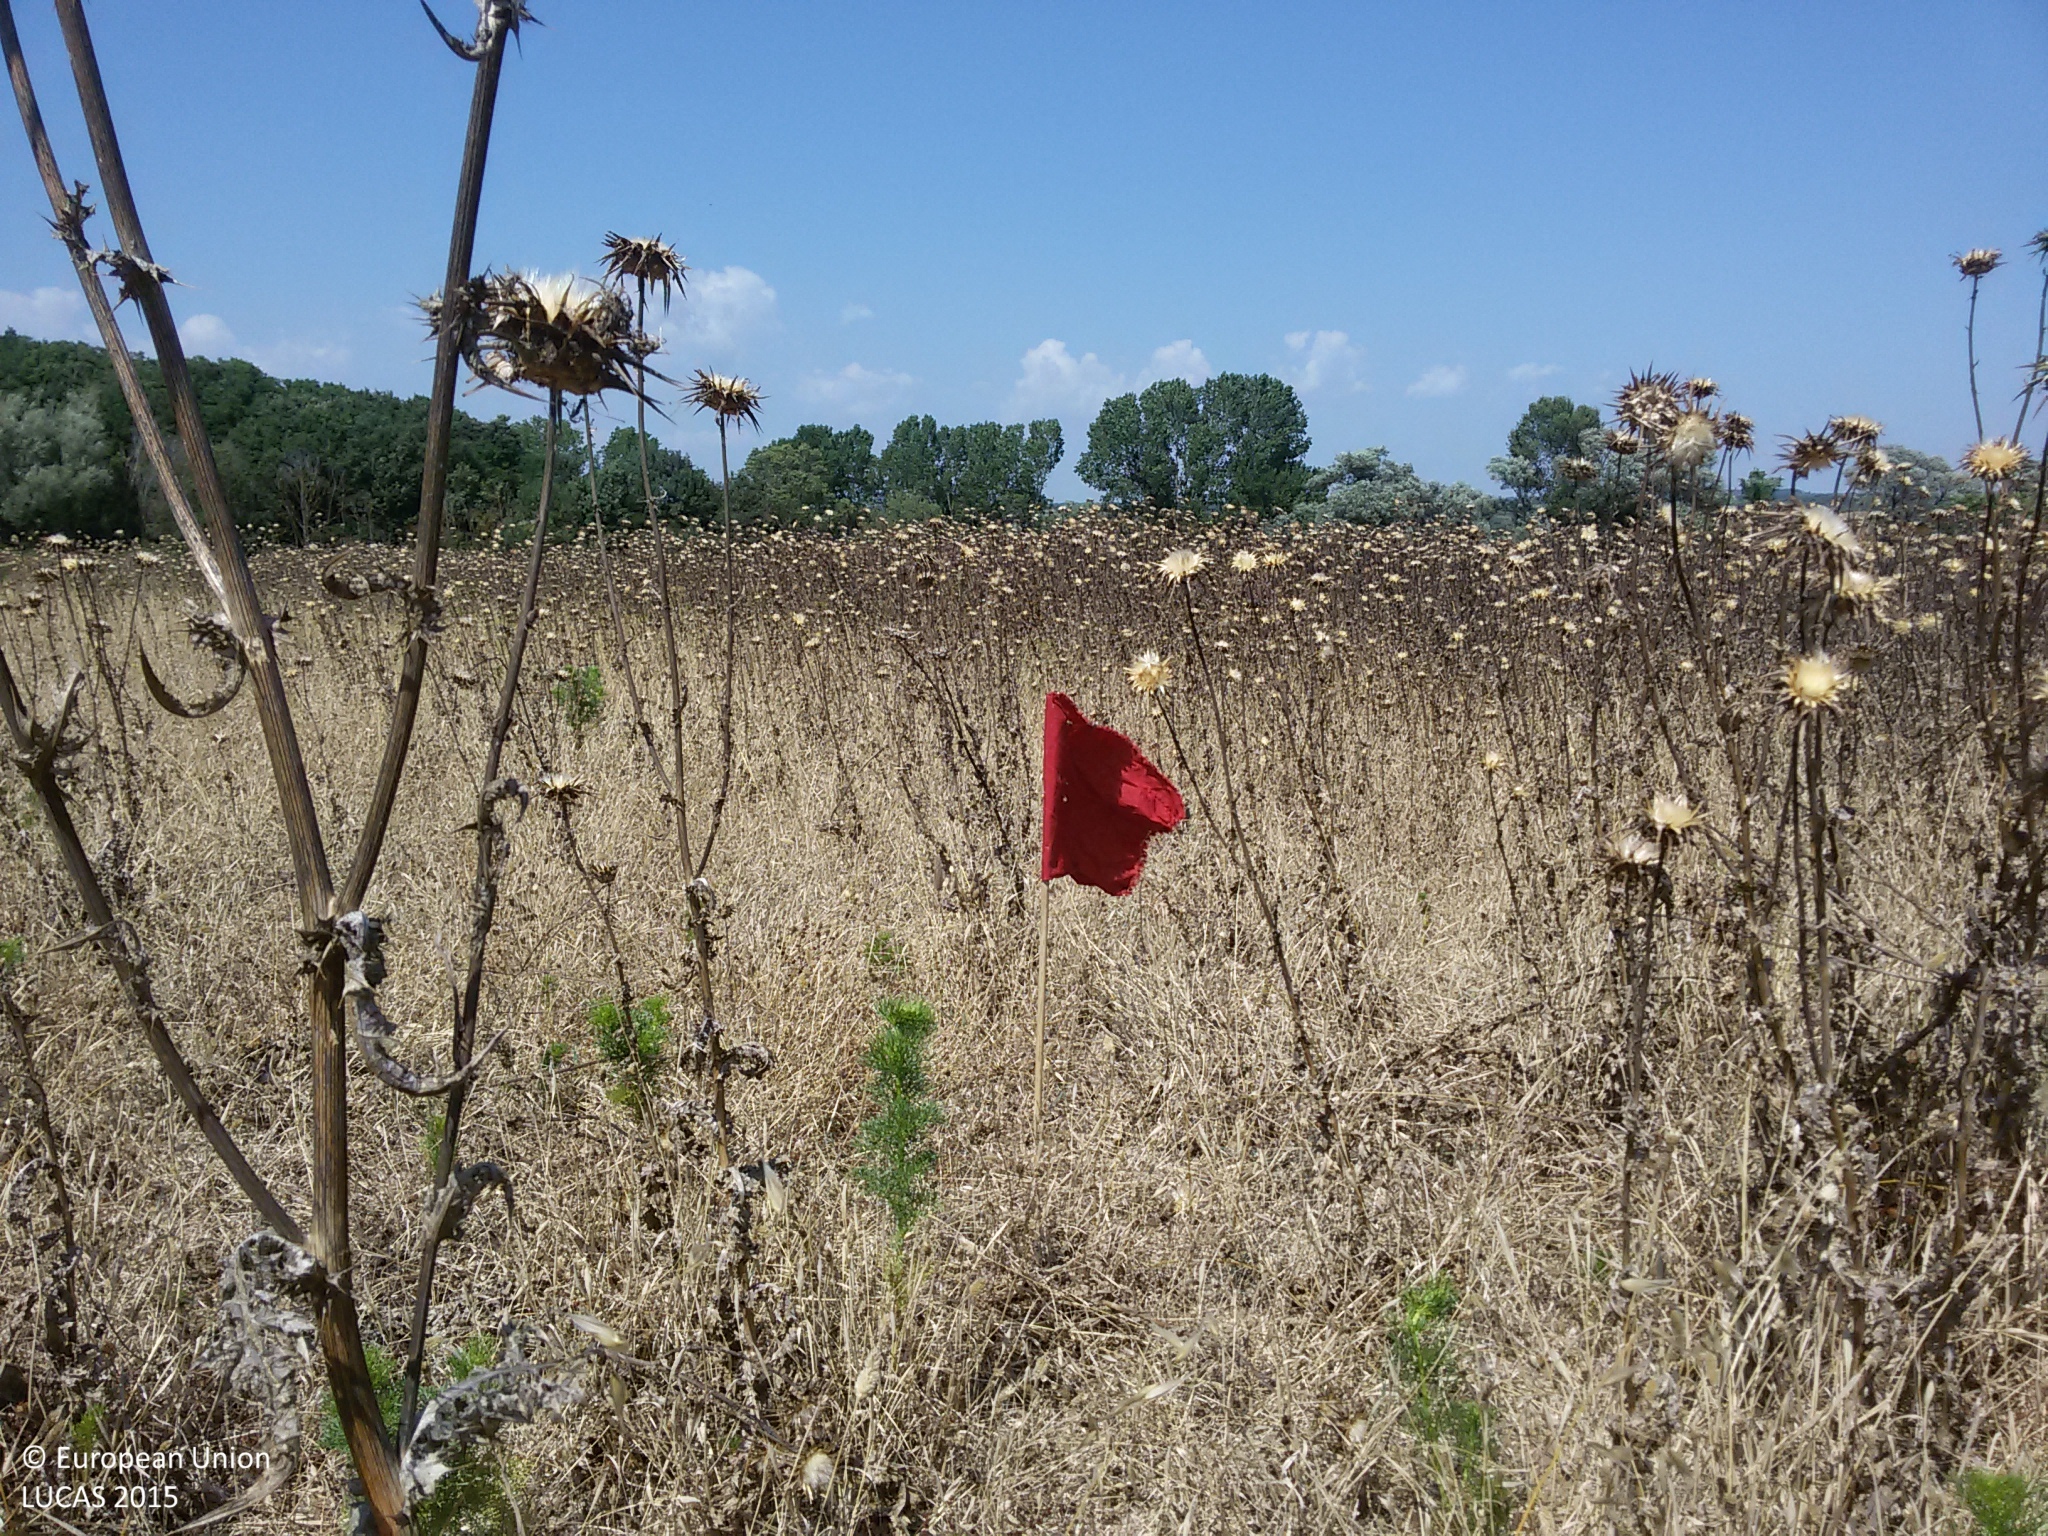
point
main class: Grassland
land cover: Grassland without tree/shrub cover
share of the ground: > 75 %
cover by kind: herbaceous plants 90 %, consolidated bare surface 5 %, unconsolidated bare surface 5 %
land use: Agriculture (excluding fallow land and kitchen gardens)
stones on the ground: 25 - 50 %
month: July
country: IT
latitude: 42.4605
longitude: 11.6118
